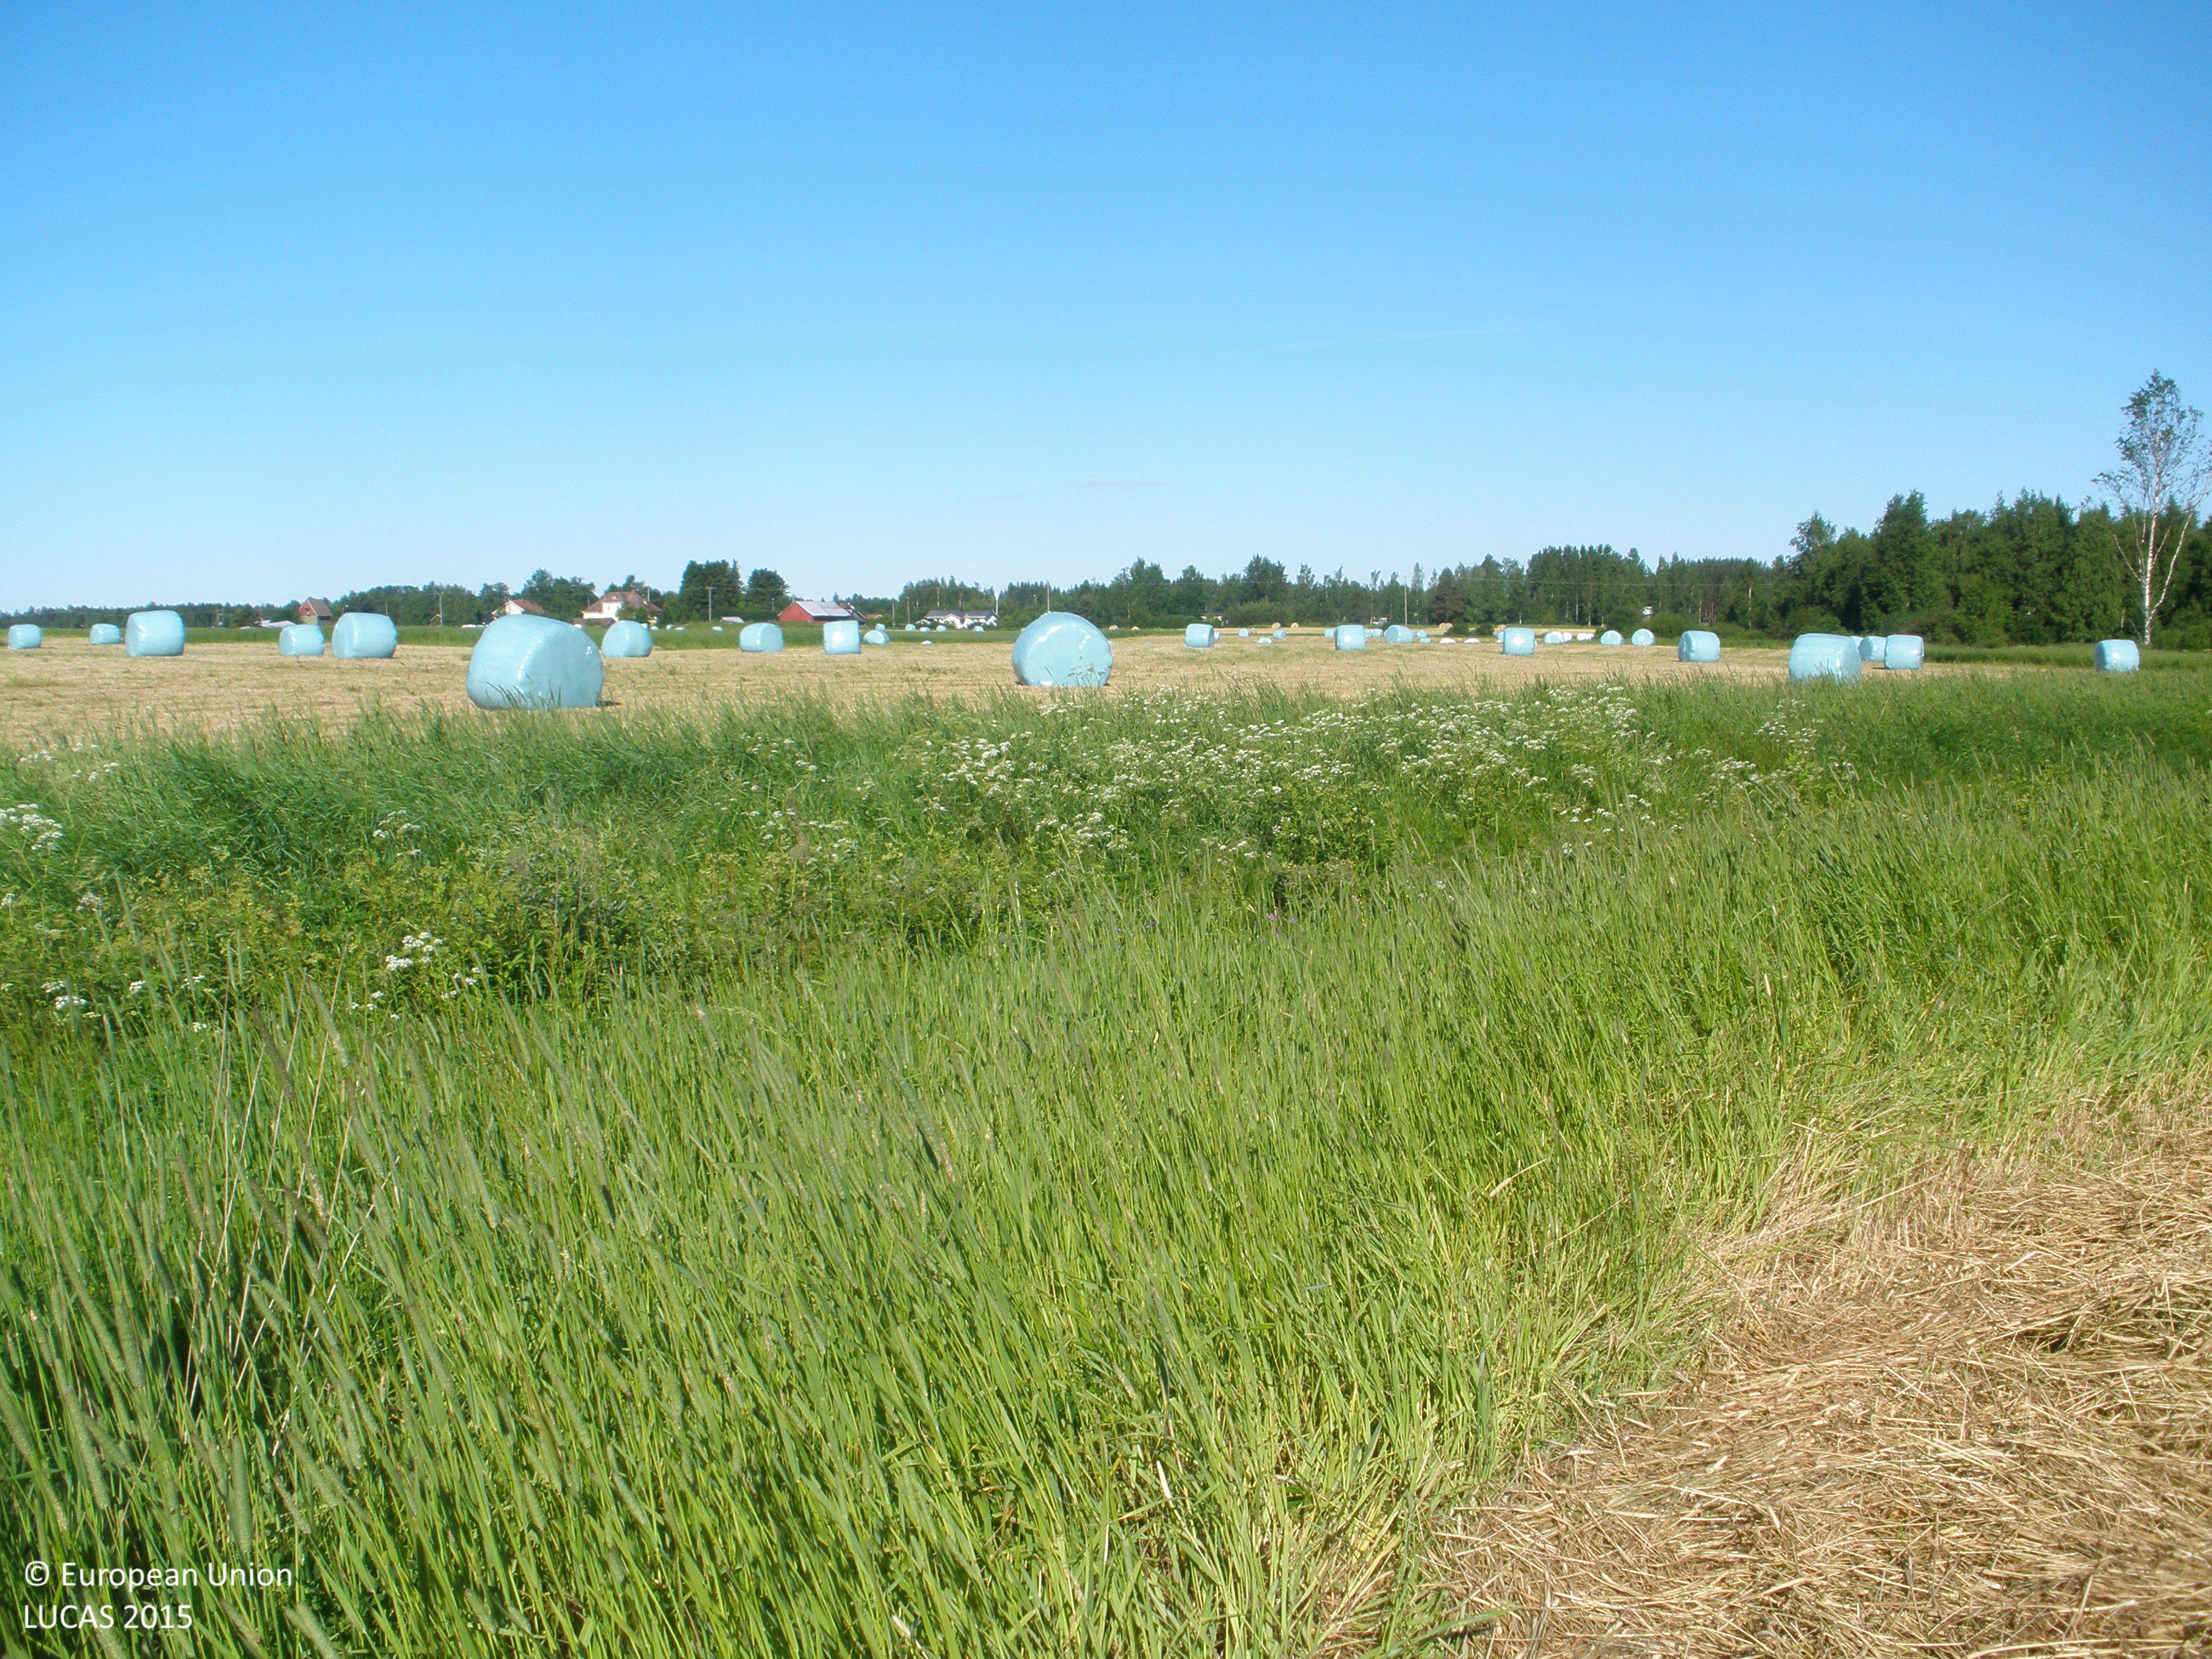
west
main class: Cropland
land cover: Mixed cereals for fodder
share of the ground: 25 - 50 %
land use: Agriculture (excluding fallow land and kitchen gardens)
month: July
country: FI
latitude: 61.2302
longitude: 23.8903
